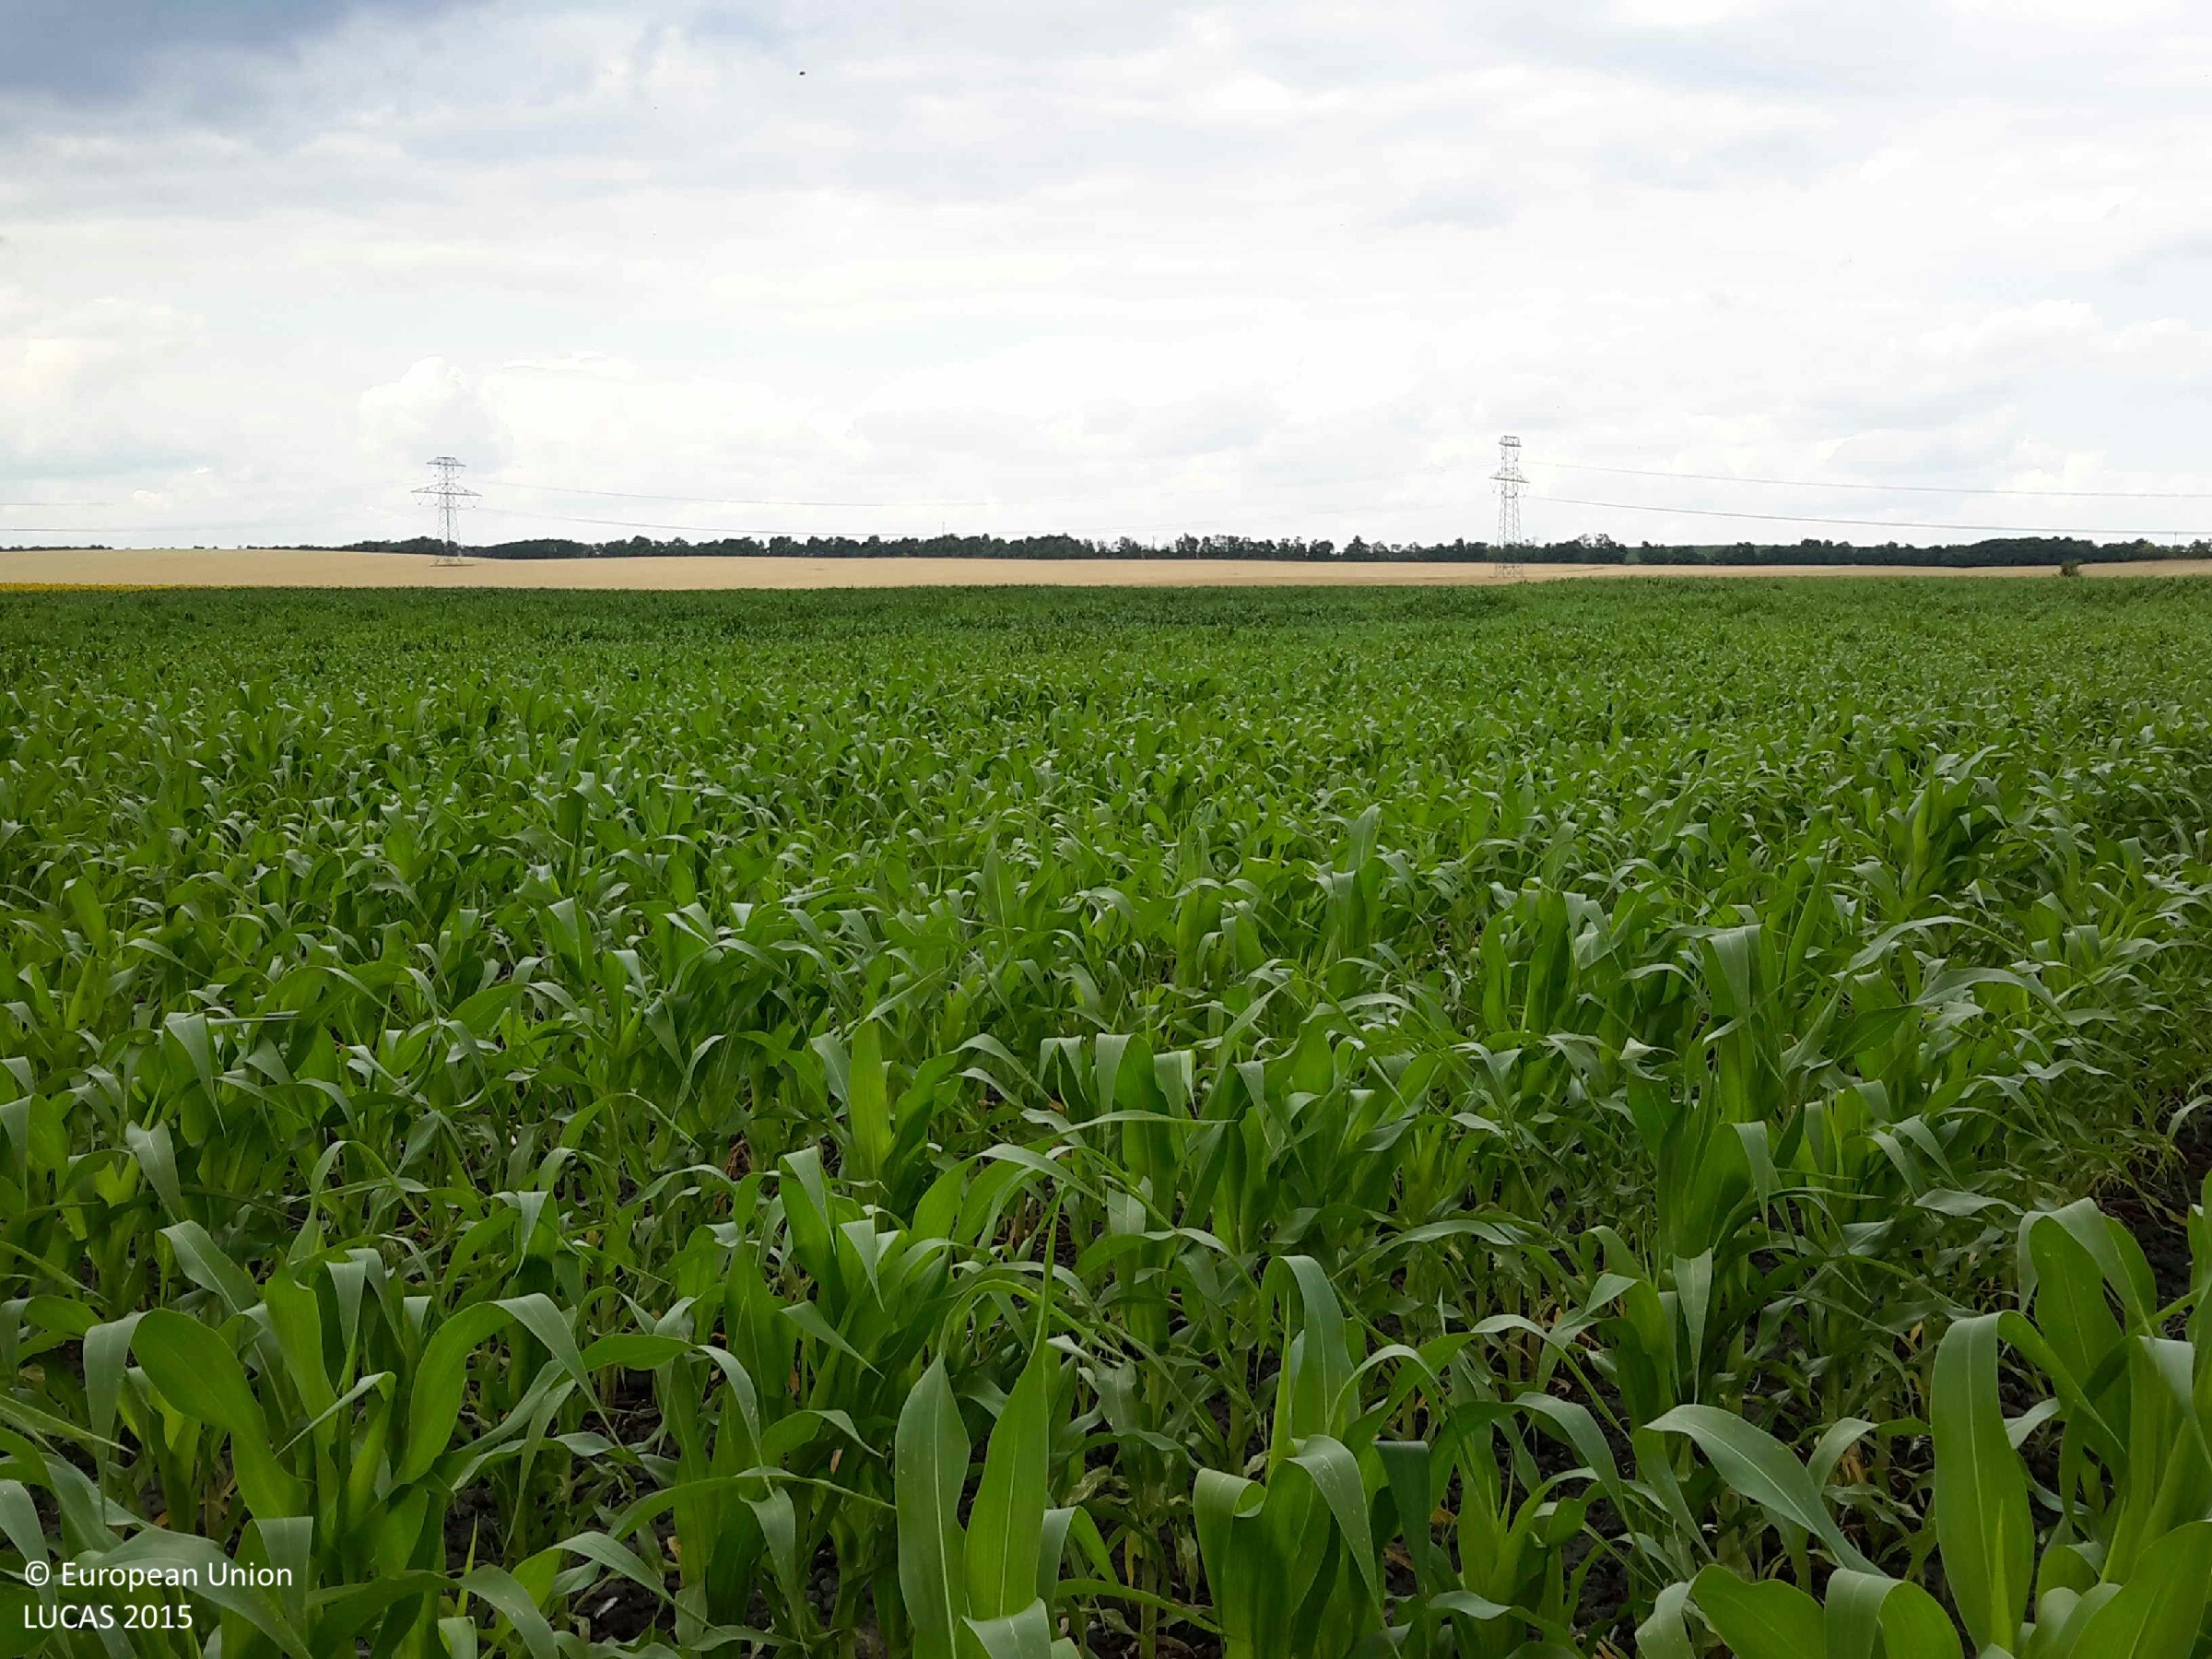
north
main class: Cropland
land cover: Maize
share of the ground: > 75 %
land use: Agriculture (excluding fallow land and kitchen gardens)
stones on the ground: < 10 %
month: July
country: HU
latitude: 47.6398
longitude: 17.7967
